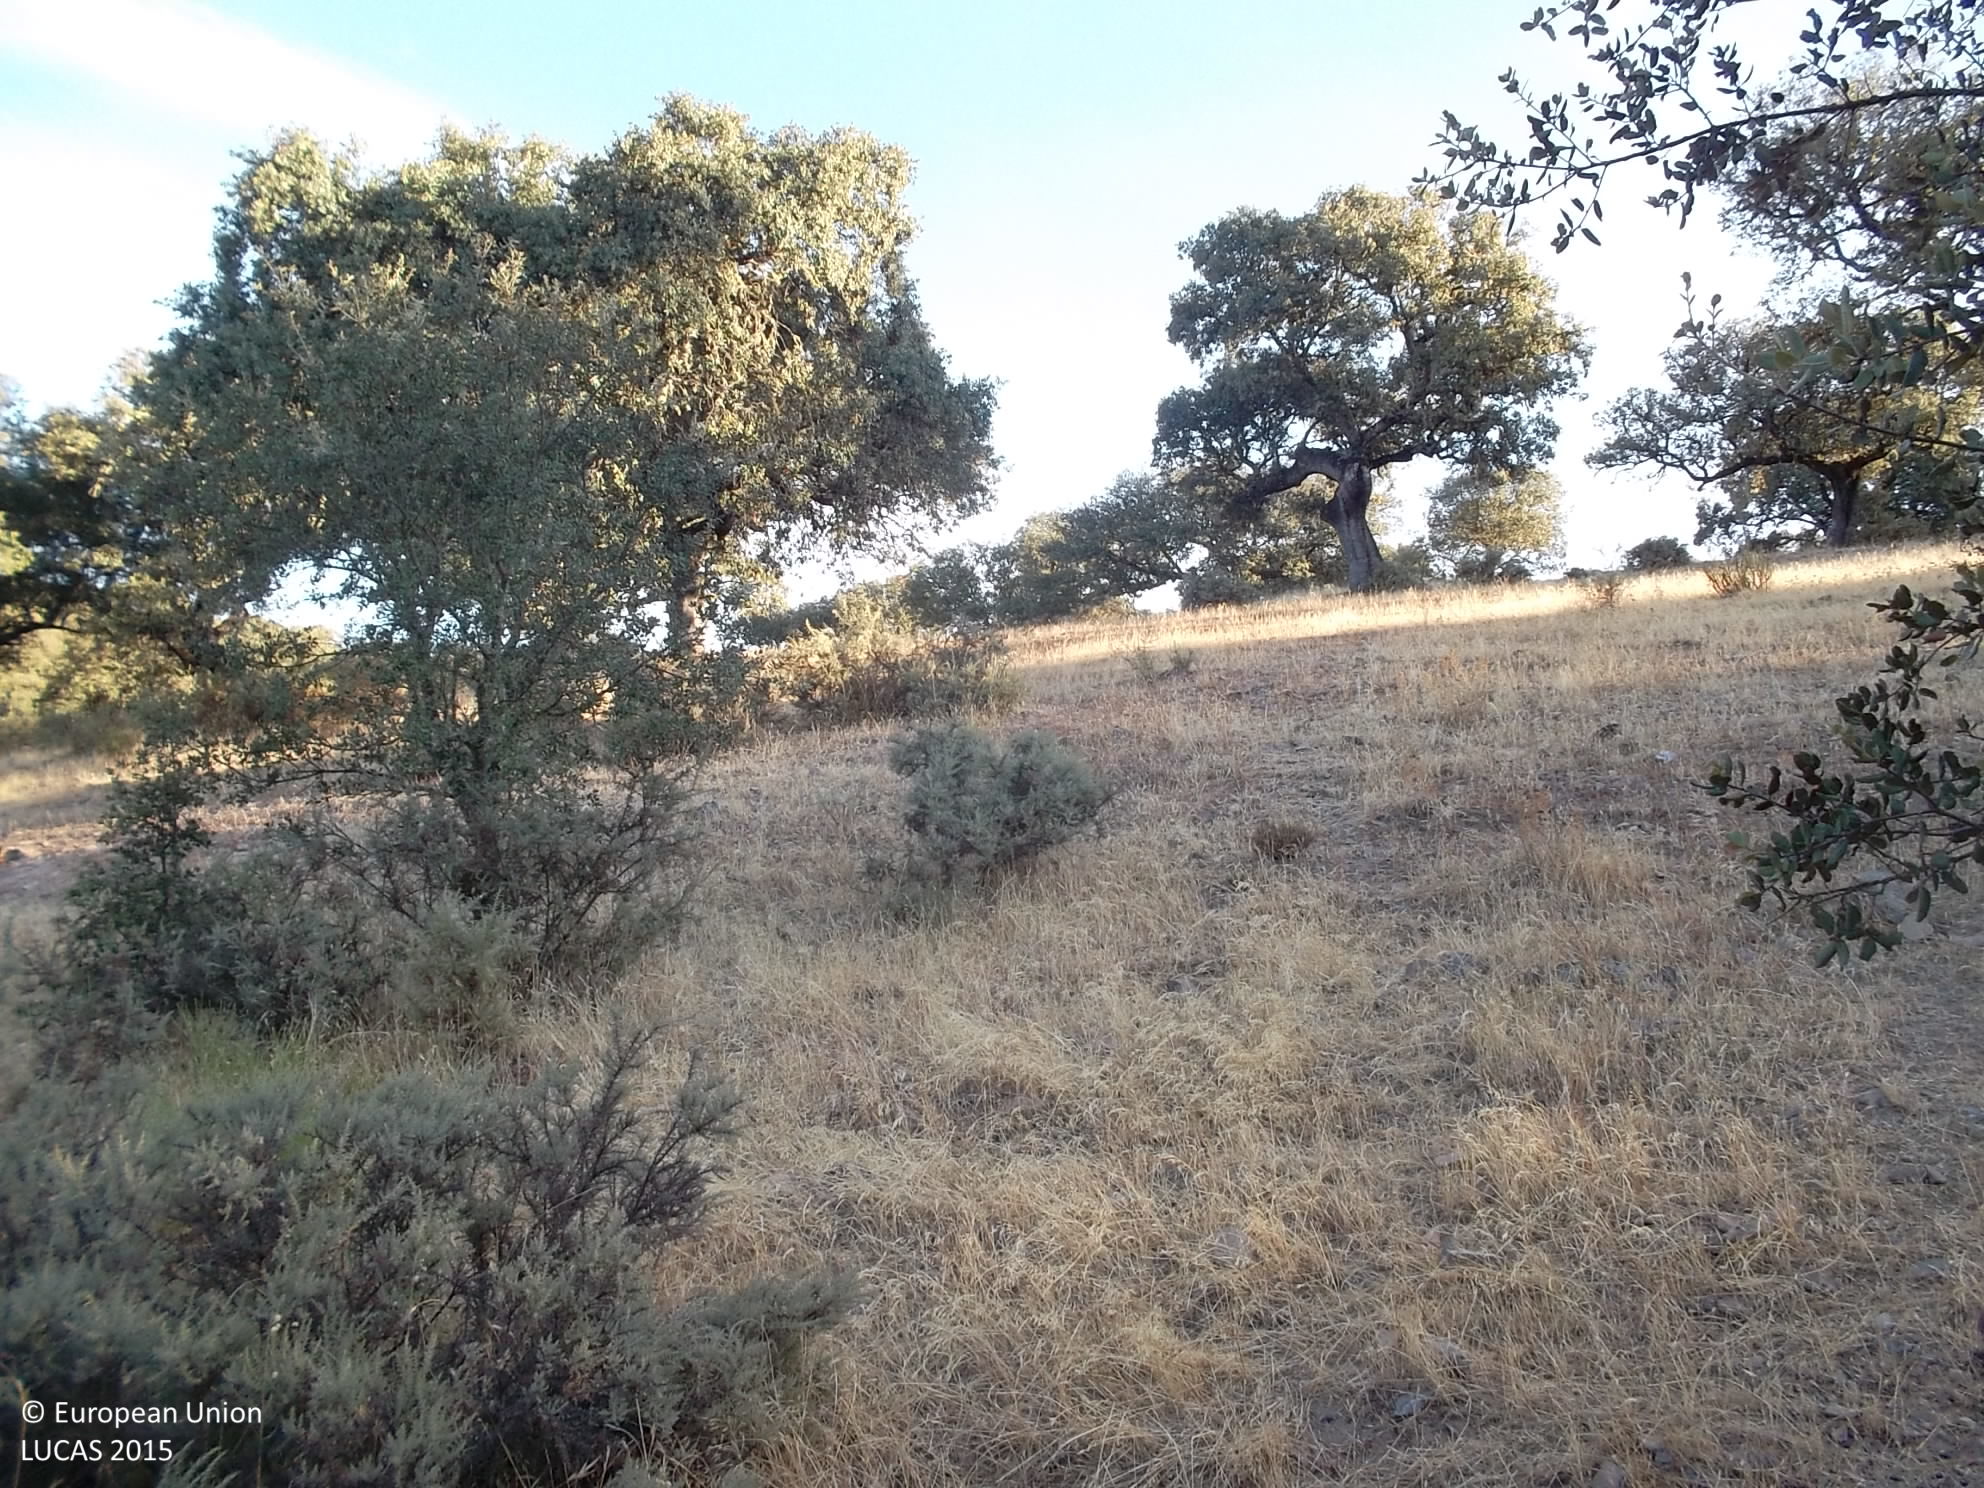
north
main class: Woodland
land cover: Broadleaved woodland
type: broadleaved evergreen forest
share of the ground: 50 - 75 %
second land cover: Grassland without tree/shrub cover
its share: > 75 %
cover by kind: broadleaved forest trees 50 %, herbaceous plants 50 %
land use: Forestry
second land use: Agriculture (excluding fallow land and kitchen gardens)
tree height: < 5 m
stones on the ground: 10 - 25 %
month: August
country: ES
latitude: 38.1151
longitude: -6.6446
